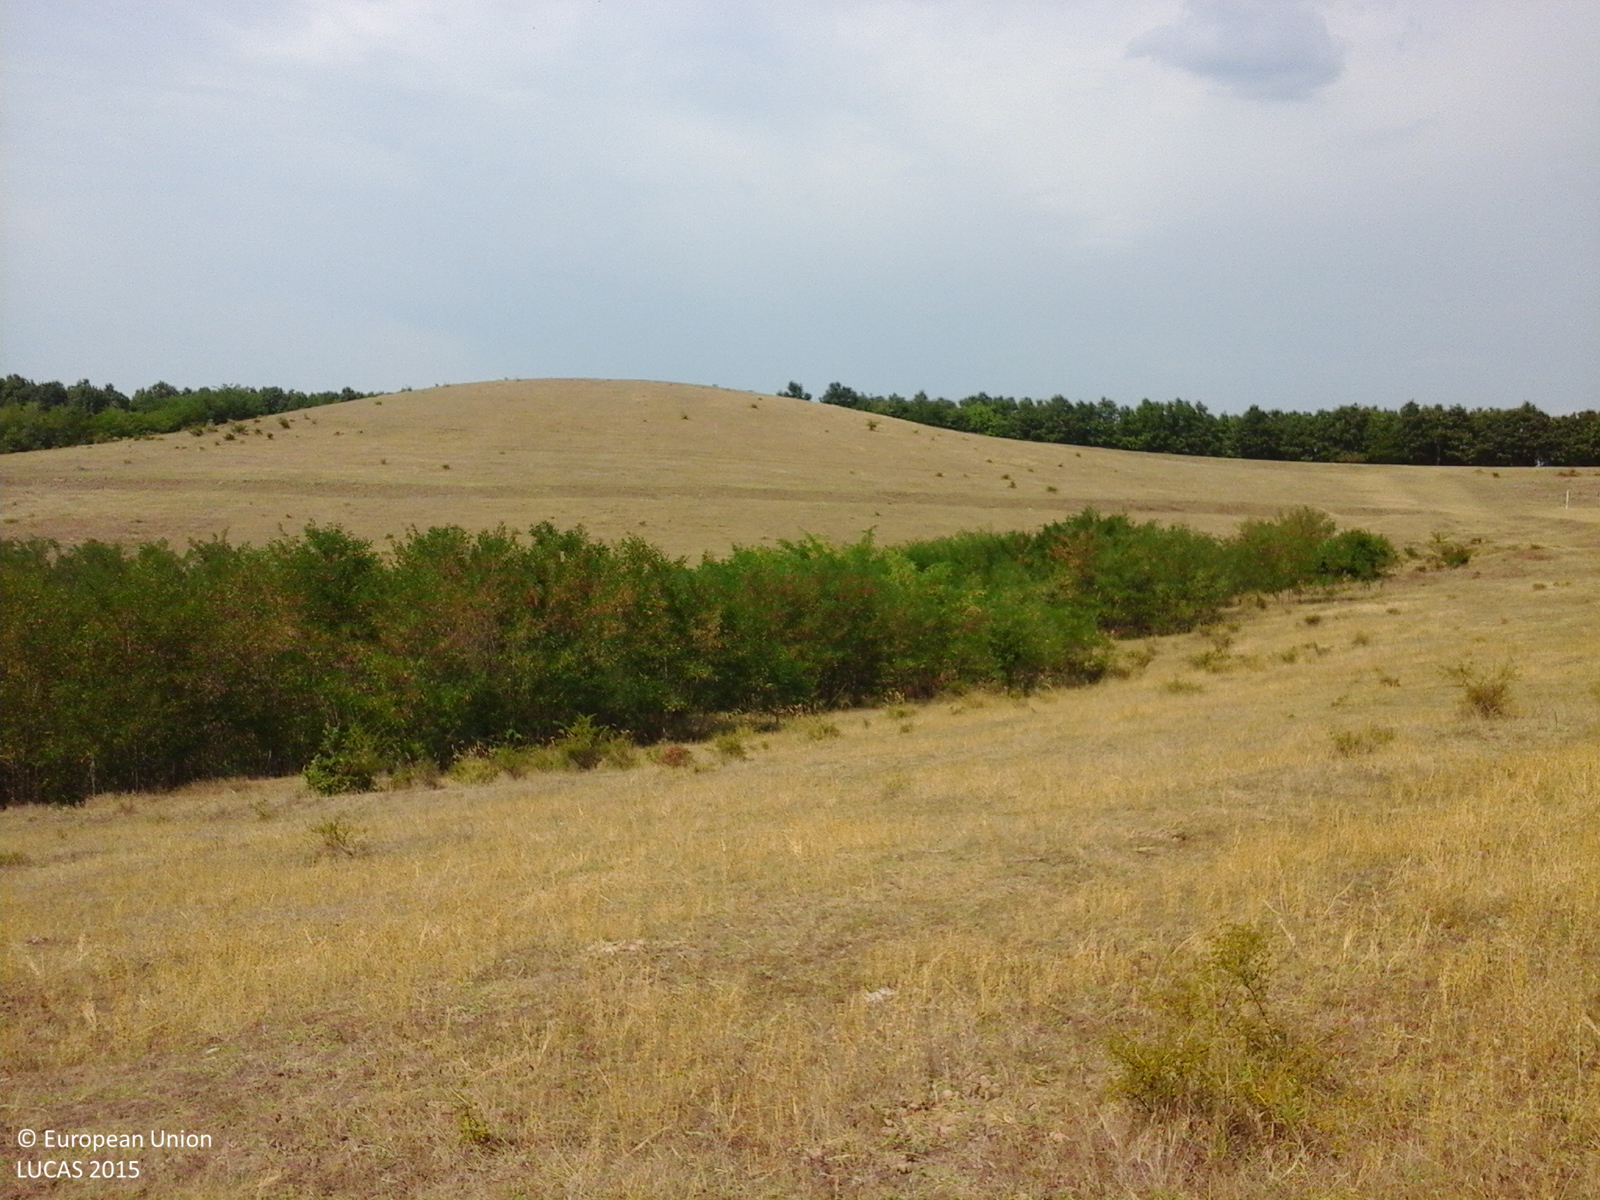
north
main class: Grassland
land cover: Grassland with sparse tree/shrub cover
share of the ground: > 75 %
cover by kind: herbaceous plants 85 %, shrubs 10 %, broadleaved forest trees 5 %
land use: Agriculture (excluding fallow land and kitchen gardens)
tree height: < 5 m
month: August
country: RO
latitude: 44.6223
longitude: 23.5790
